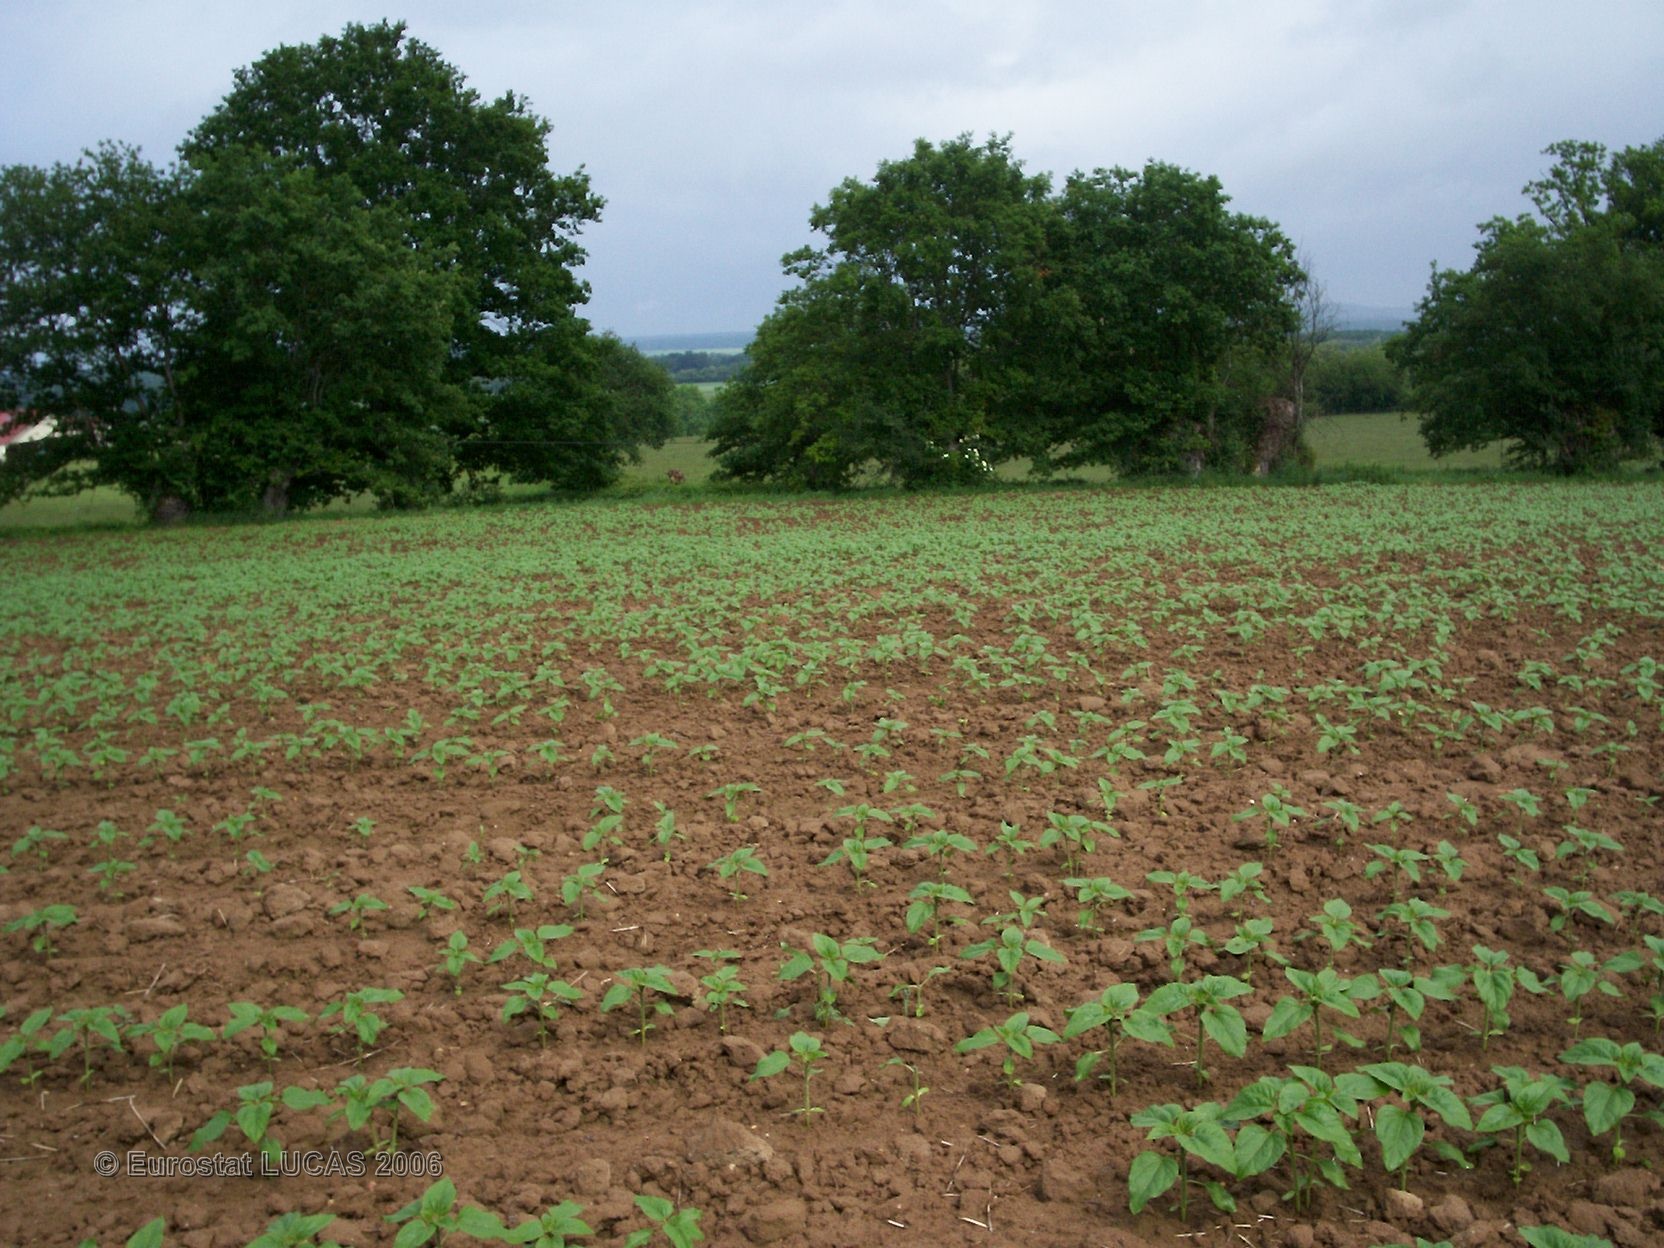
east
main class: Cropland
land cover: Sunflower
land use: Agriculture (excluding fallow land and kitchen gardens)
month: May
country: FR
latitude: 47.1514
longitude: 2.9922
